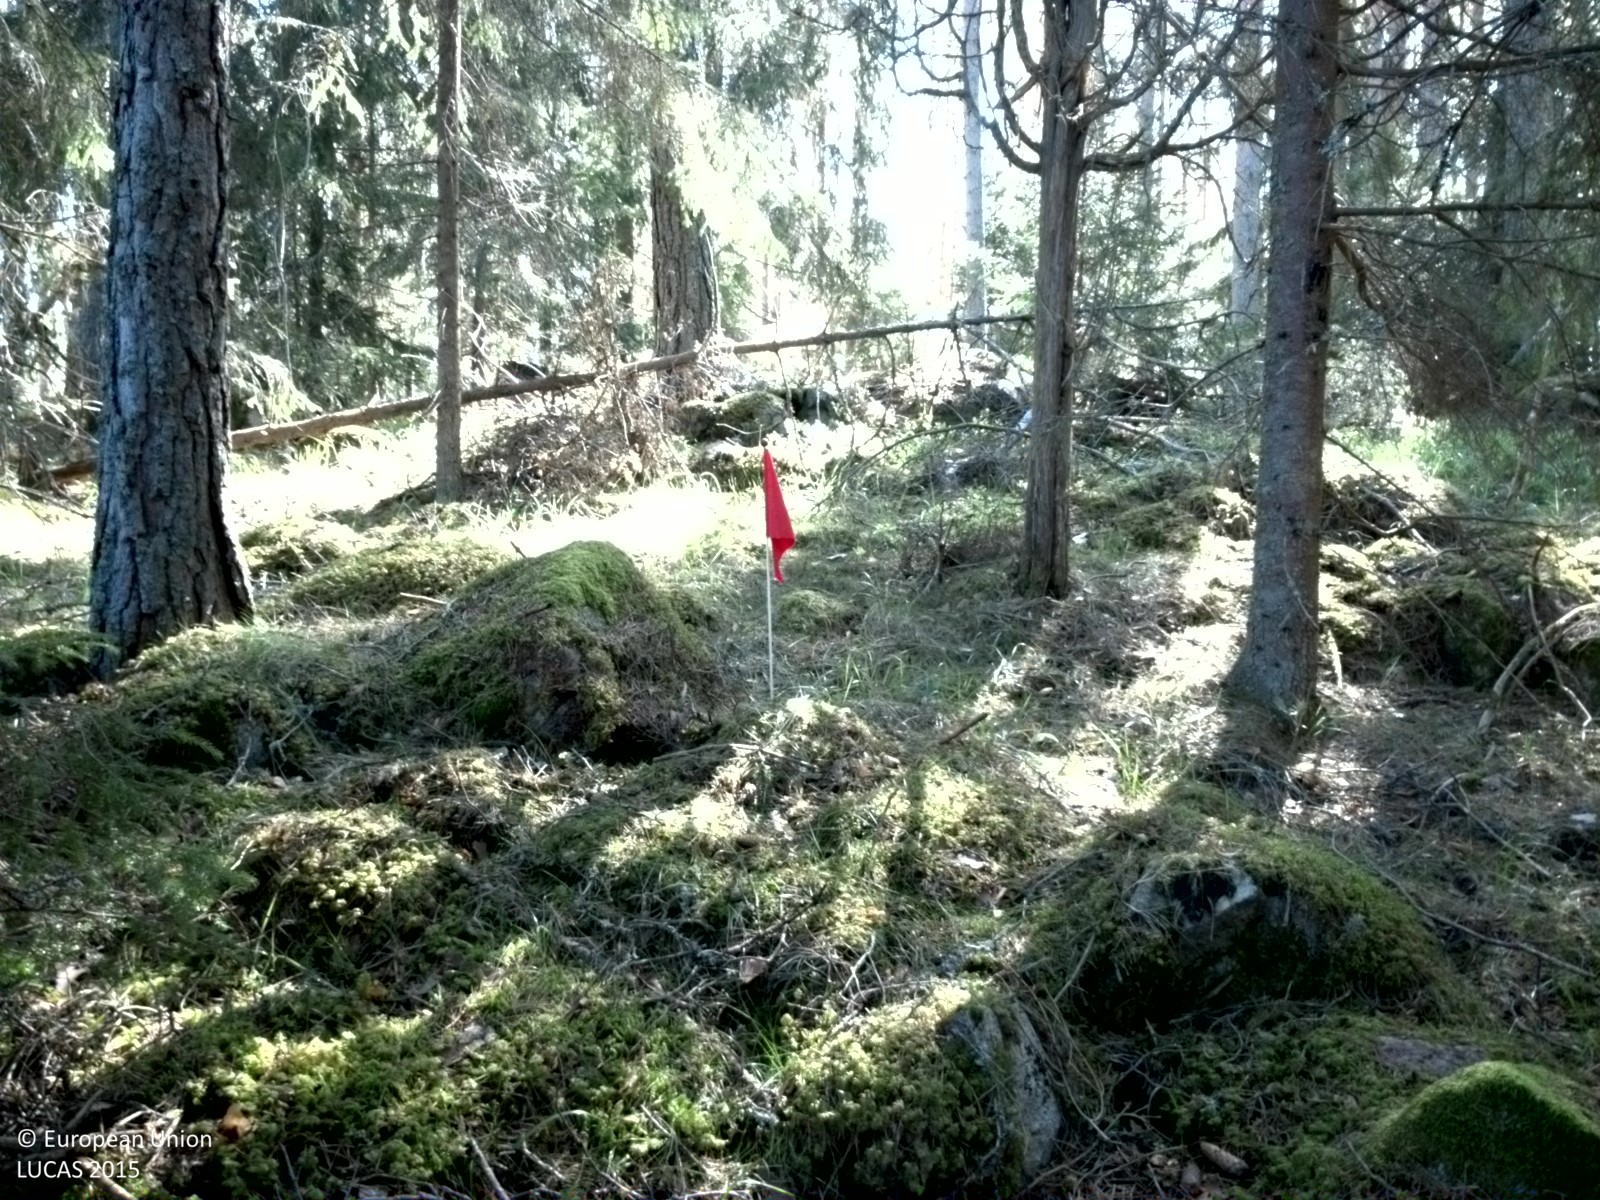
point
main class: Woodland
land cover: Spruce dominated coniferous woodland
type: boreal forest
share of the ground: > 75 %
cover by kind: coniferous forest trees 75 %, lichens and mosses 10 %, herbaceous plants 5 %, consolidated bare surface 5 %
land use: Forestry
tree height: > 5 m
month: May
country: SE
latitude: 60.1361
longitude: 17.9702
